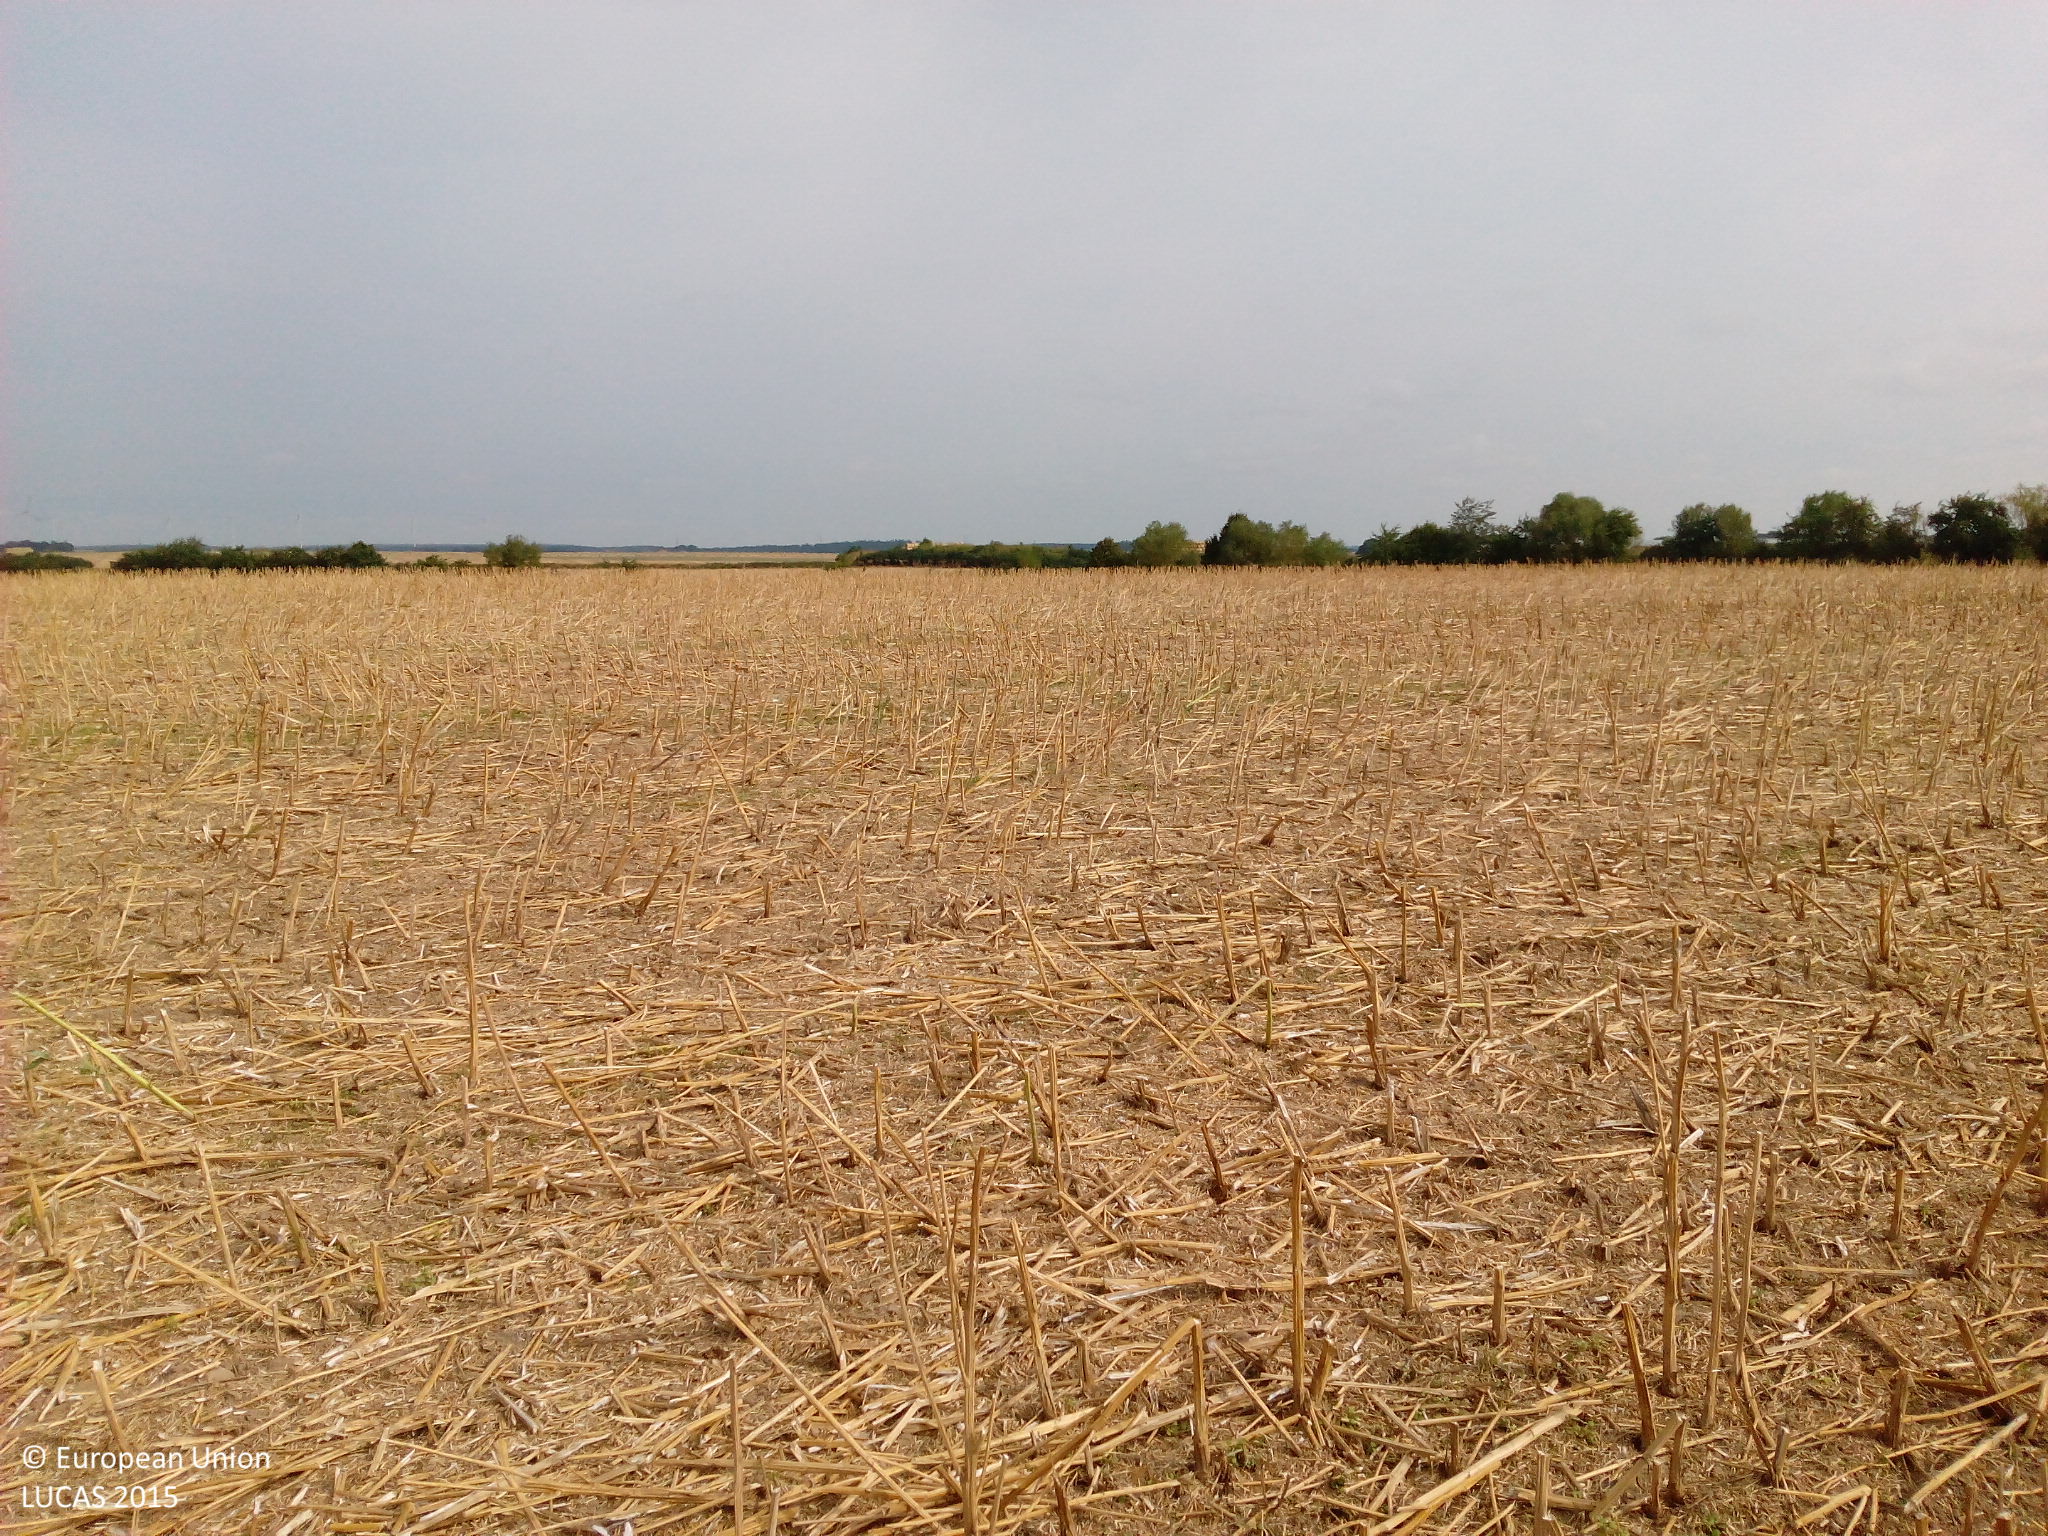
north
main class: Cropland
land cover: Rape and turnip rape
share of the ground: < 10 %
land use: Agriculture (excluding fallow land and kitchen gardens)
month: August
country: DE
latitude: 53.5931
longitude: 13.2177
